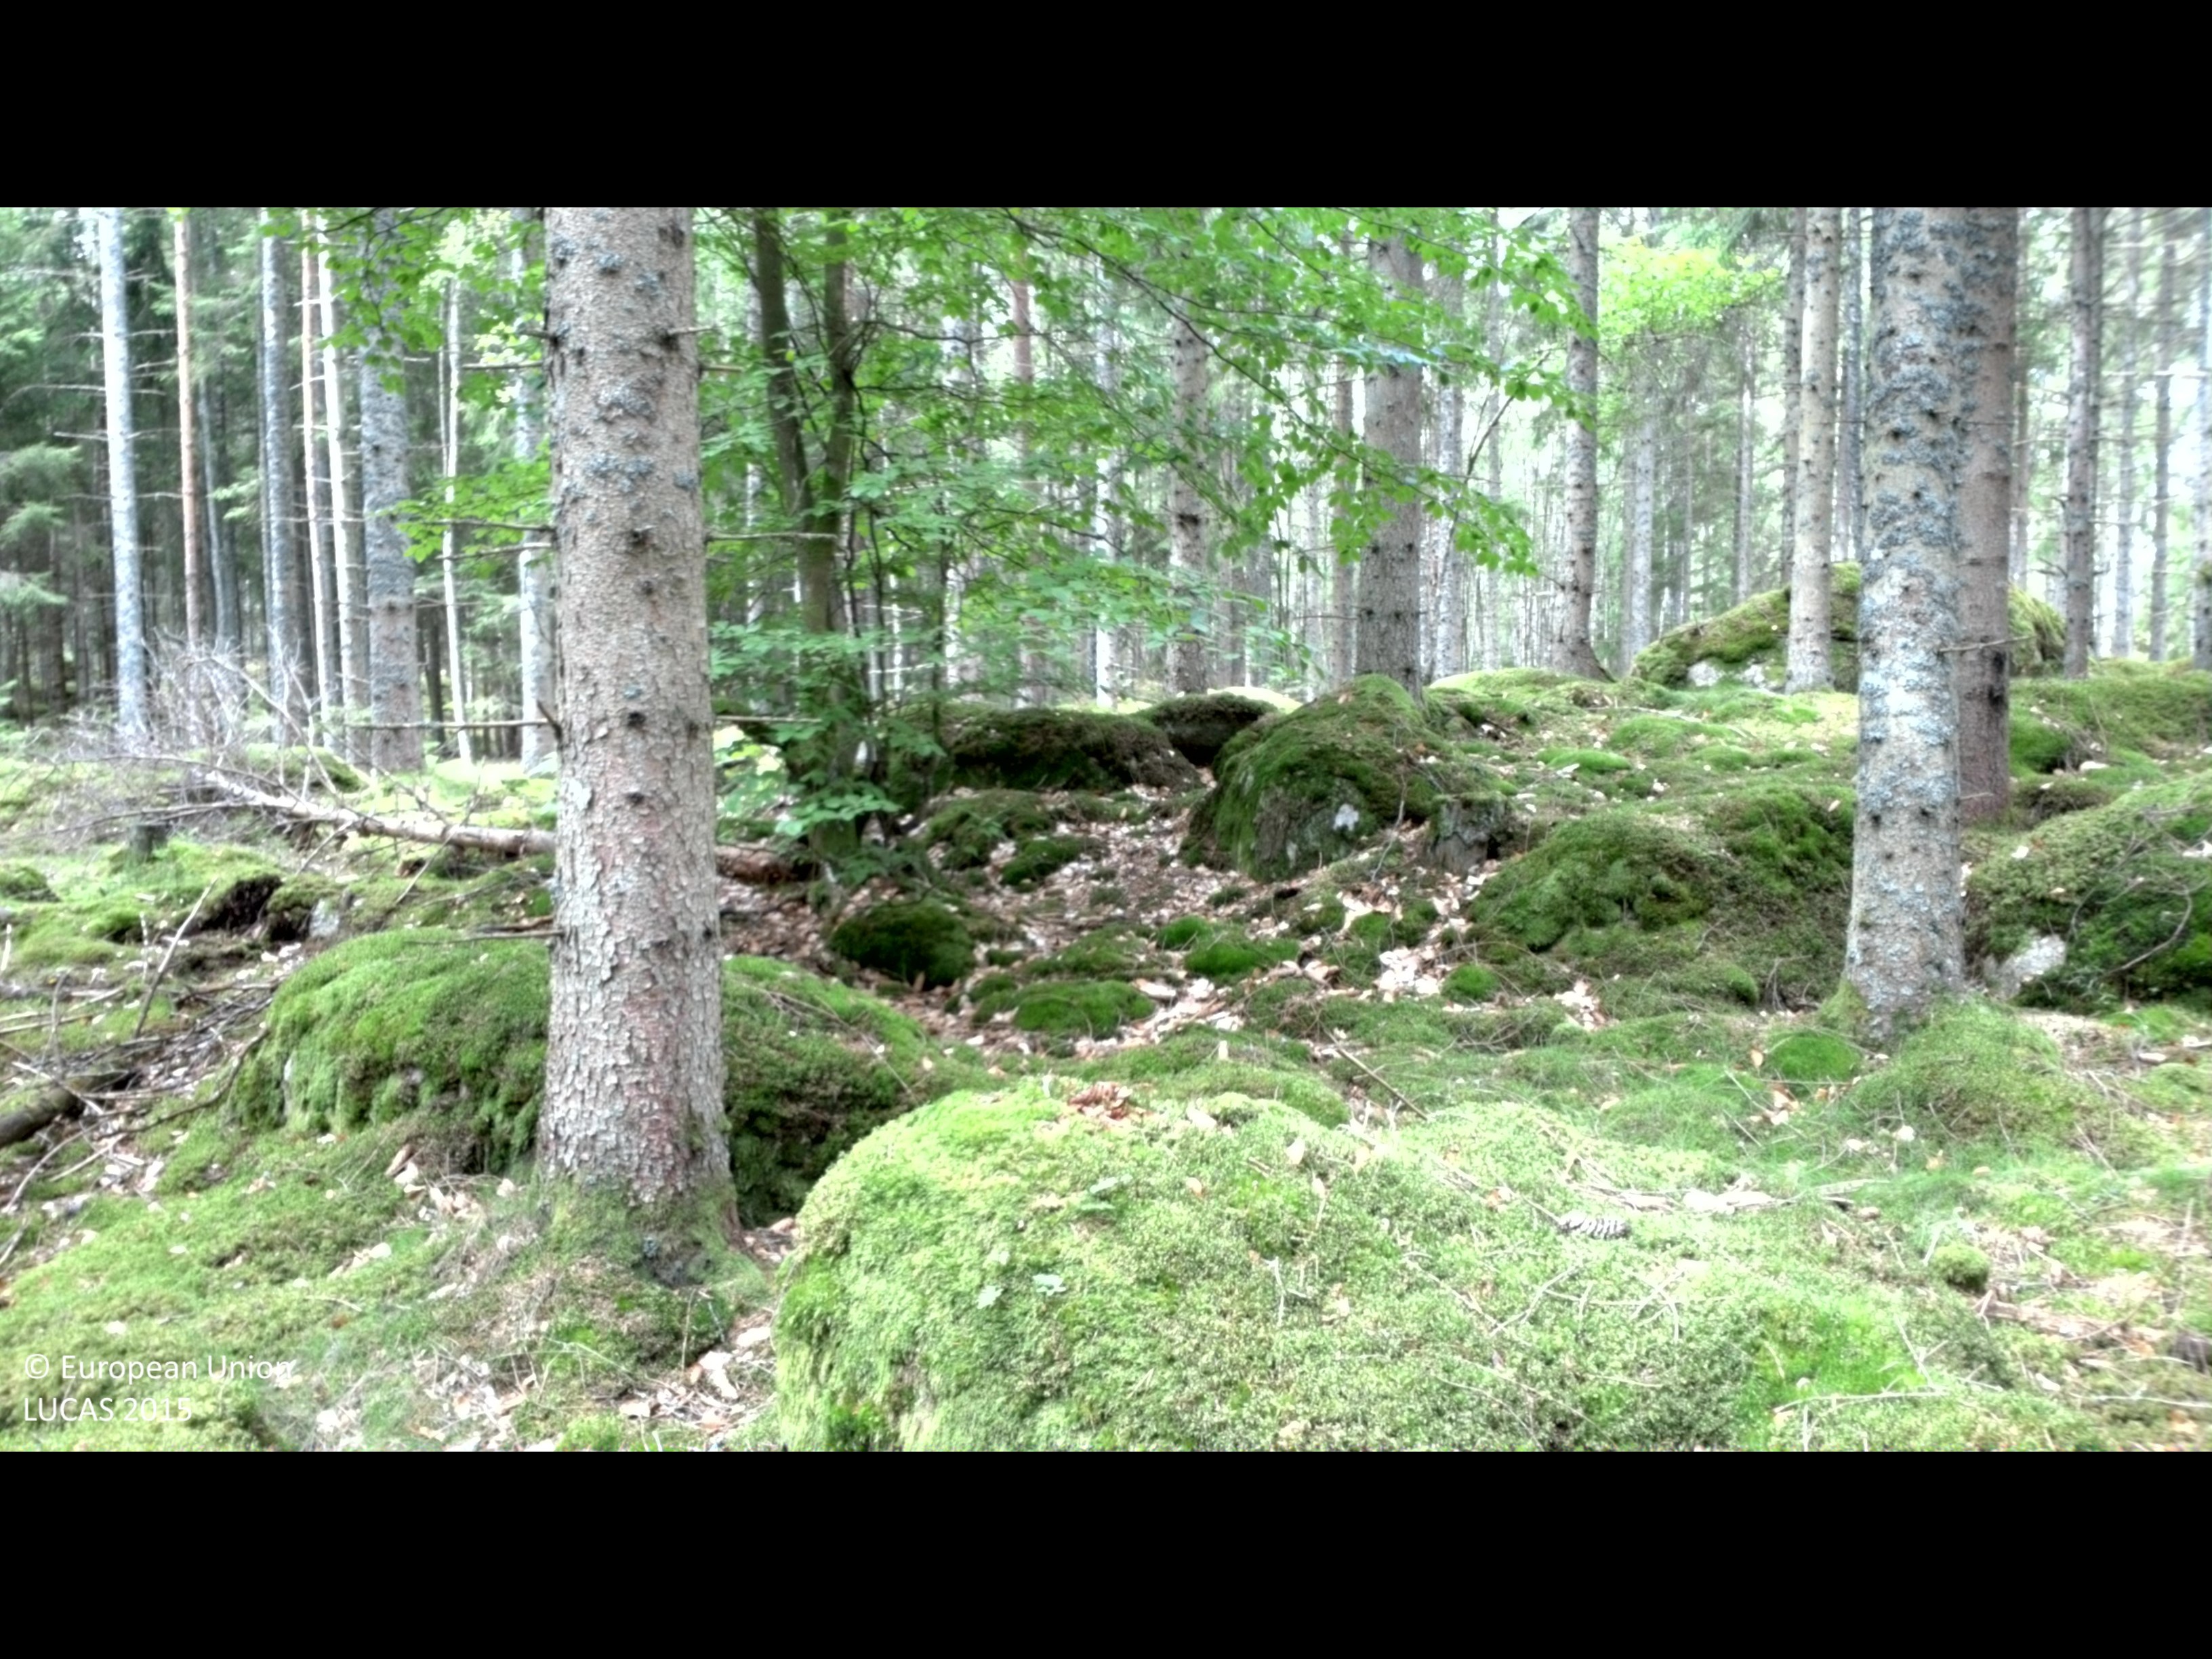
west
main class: Woodland
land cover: Spruce dominated coniferous woodland
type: boreal forest
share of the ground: > 75 %
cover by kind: coniferous forest trees 75 %, lichens and mosses 25 %
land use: Forestry
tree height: > 5 m
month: August
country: SE
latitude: 56.4312
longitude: 14.5543
